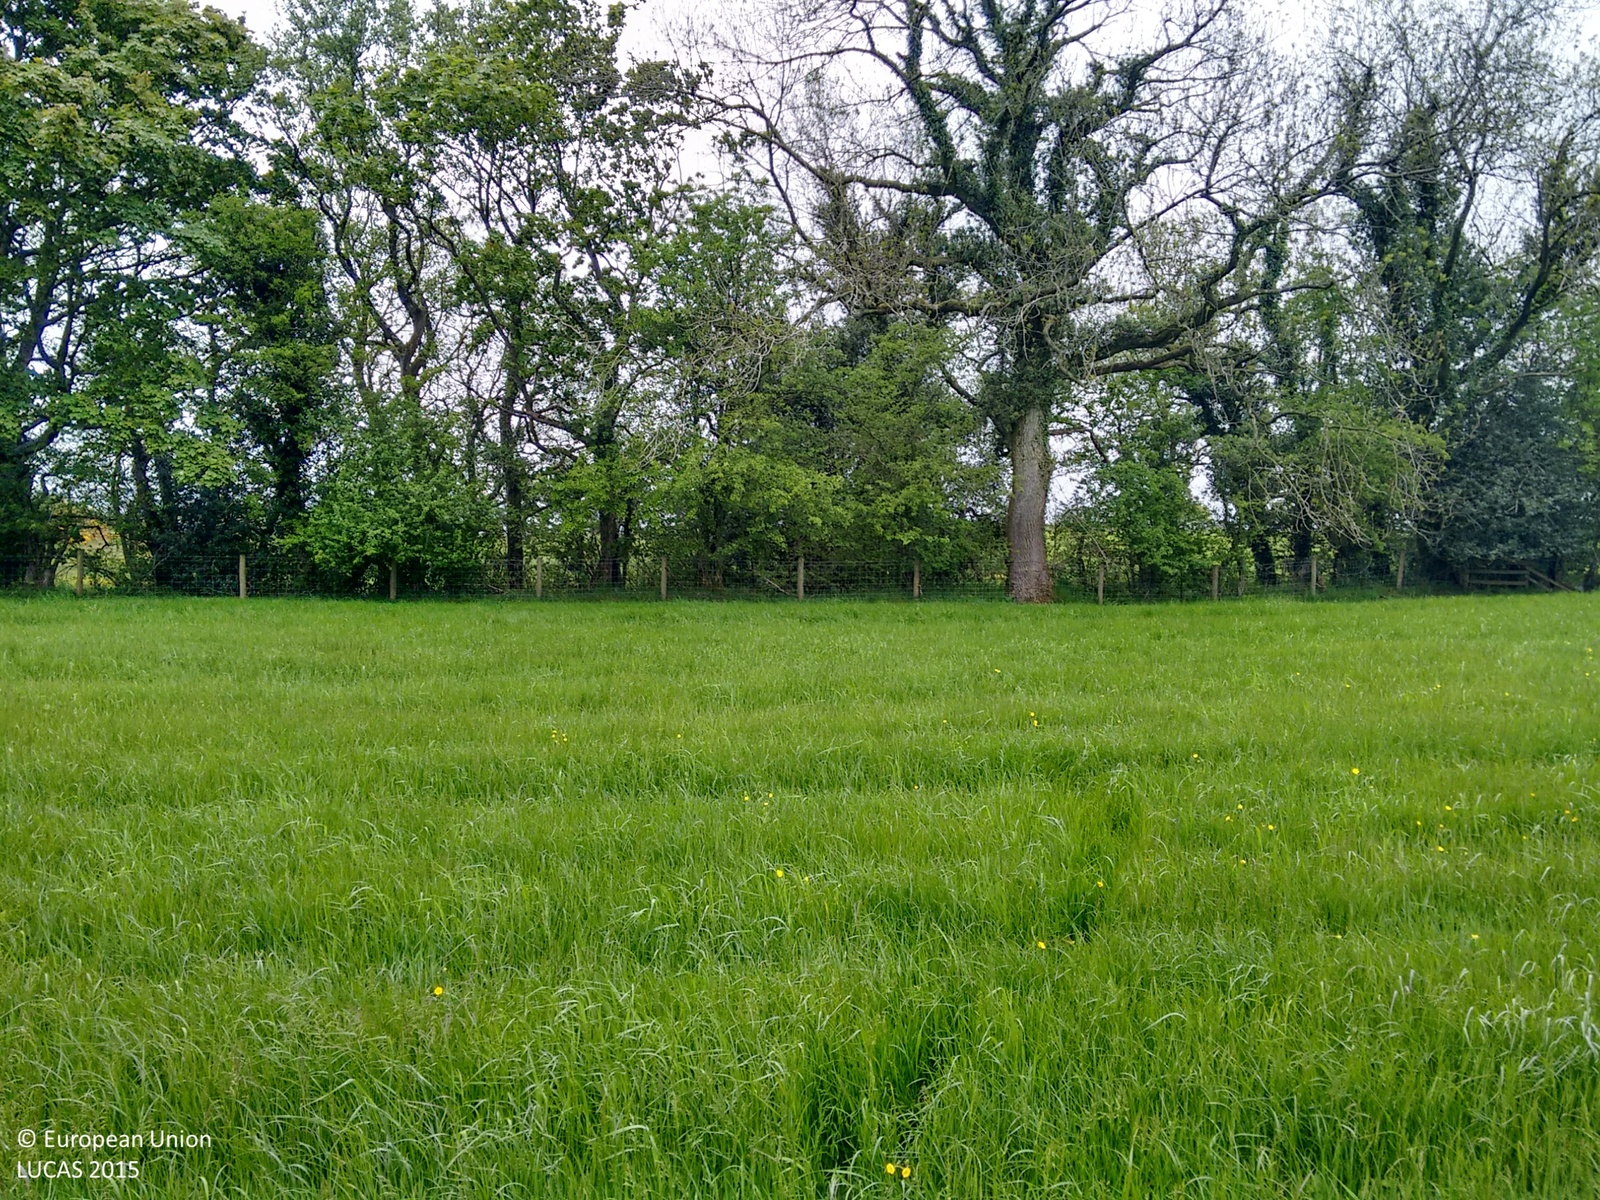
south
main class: Grassland
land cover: Grassland without tree/shrub cover
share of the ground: > 75 %
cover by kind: herbaceous plants 100 %
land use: Agriculture (excluding fallow land and kitchen gardens)
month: June
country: GB
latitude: 53.9757
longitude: -2.2737
